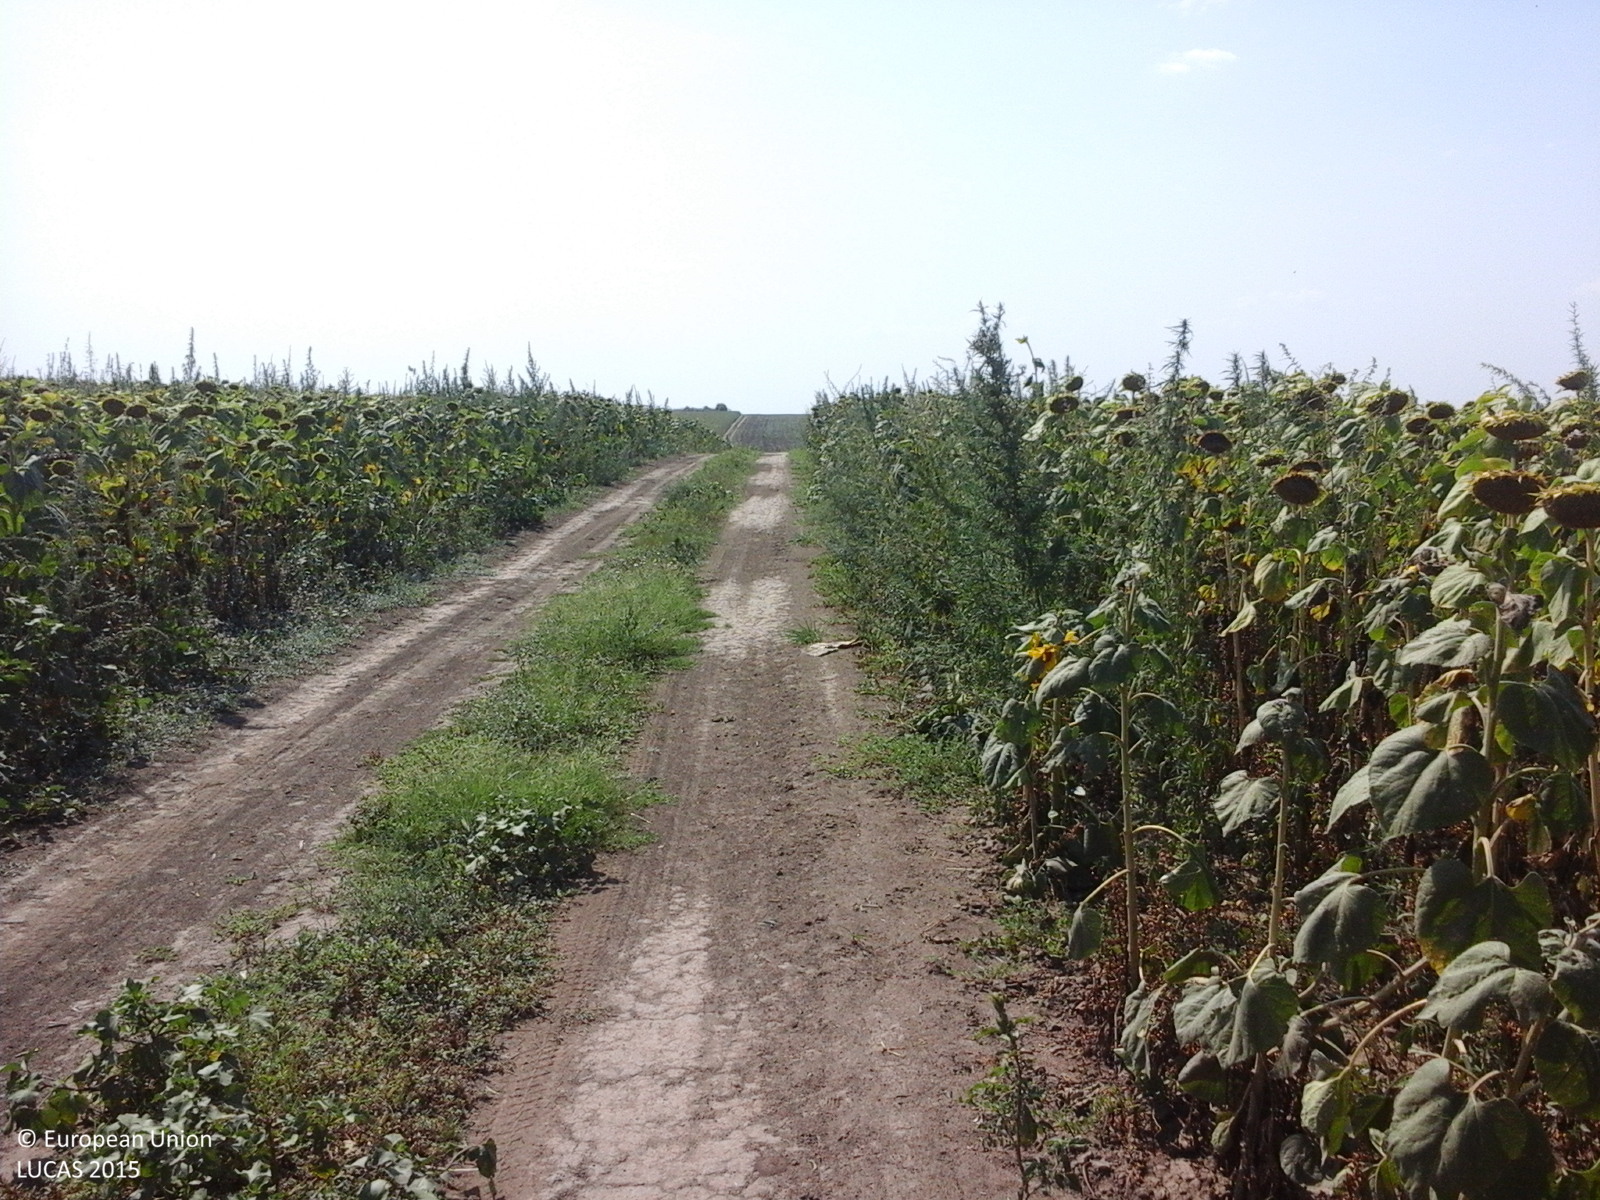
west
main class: Cropland
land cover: Sunflower
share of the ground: > 75 %
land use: Agriculture (excluding fallow land and kitchen gardens)
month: August
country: RO
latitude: 44.1800
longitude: 28.0042
